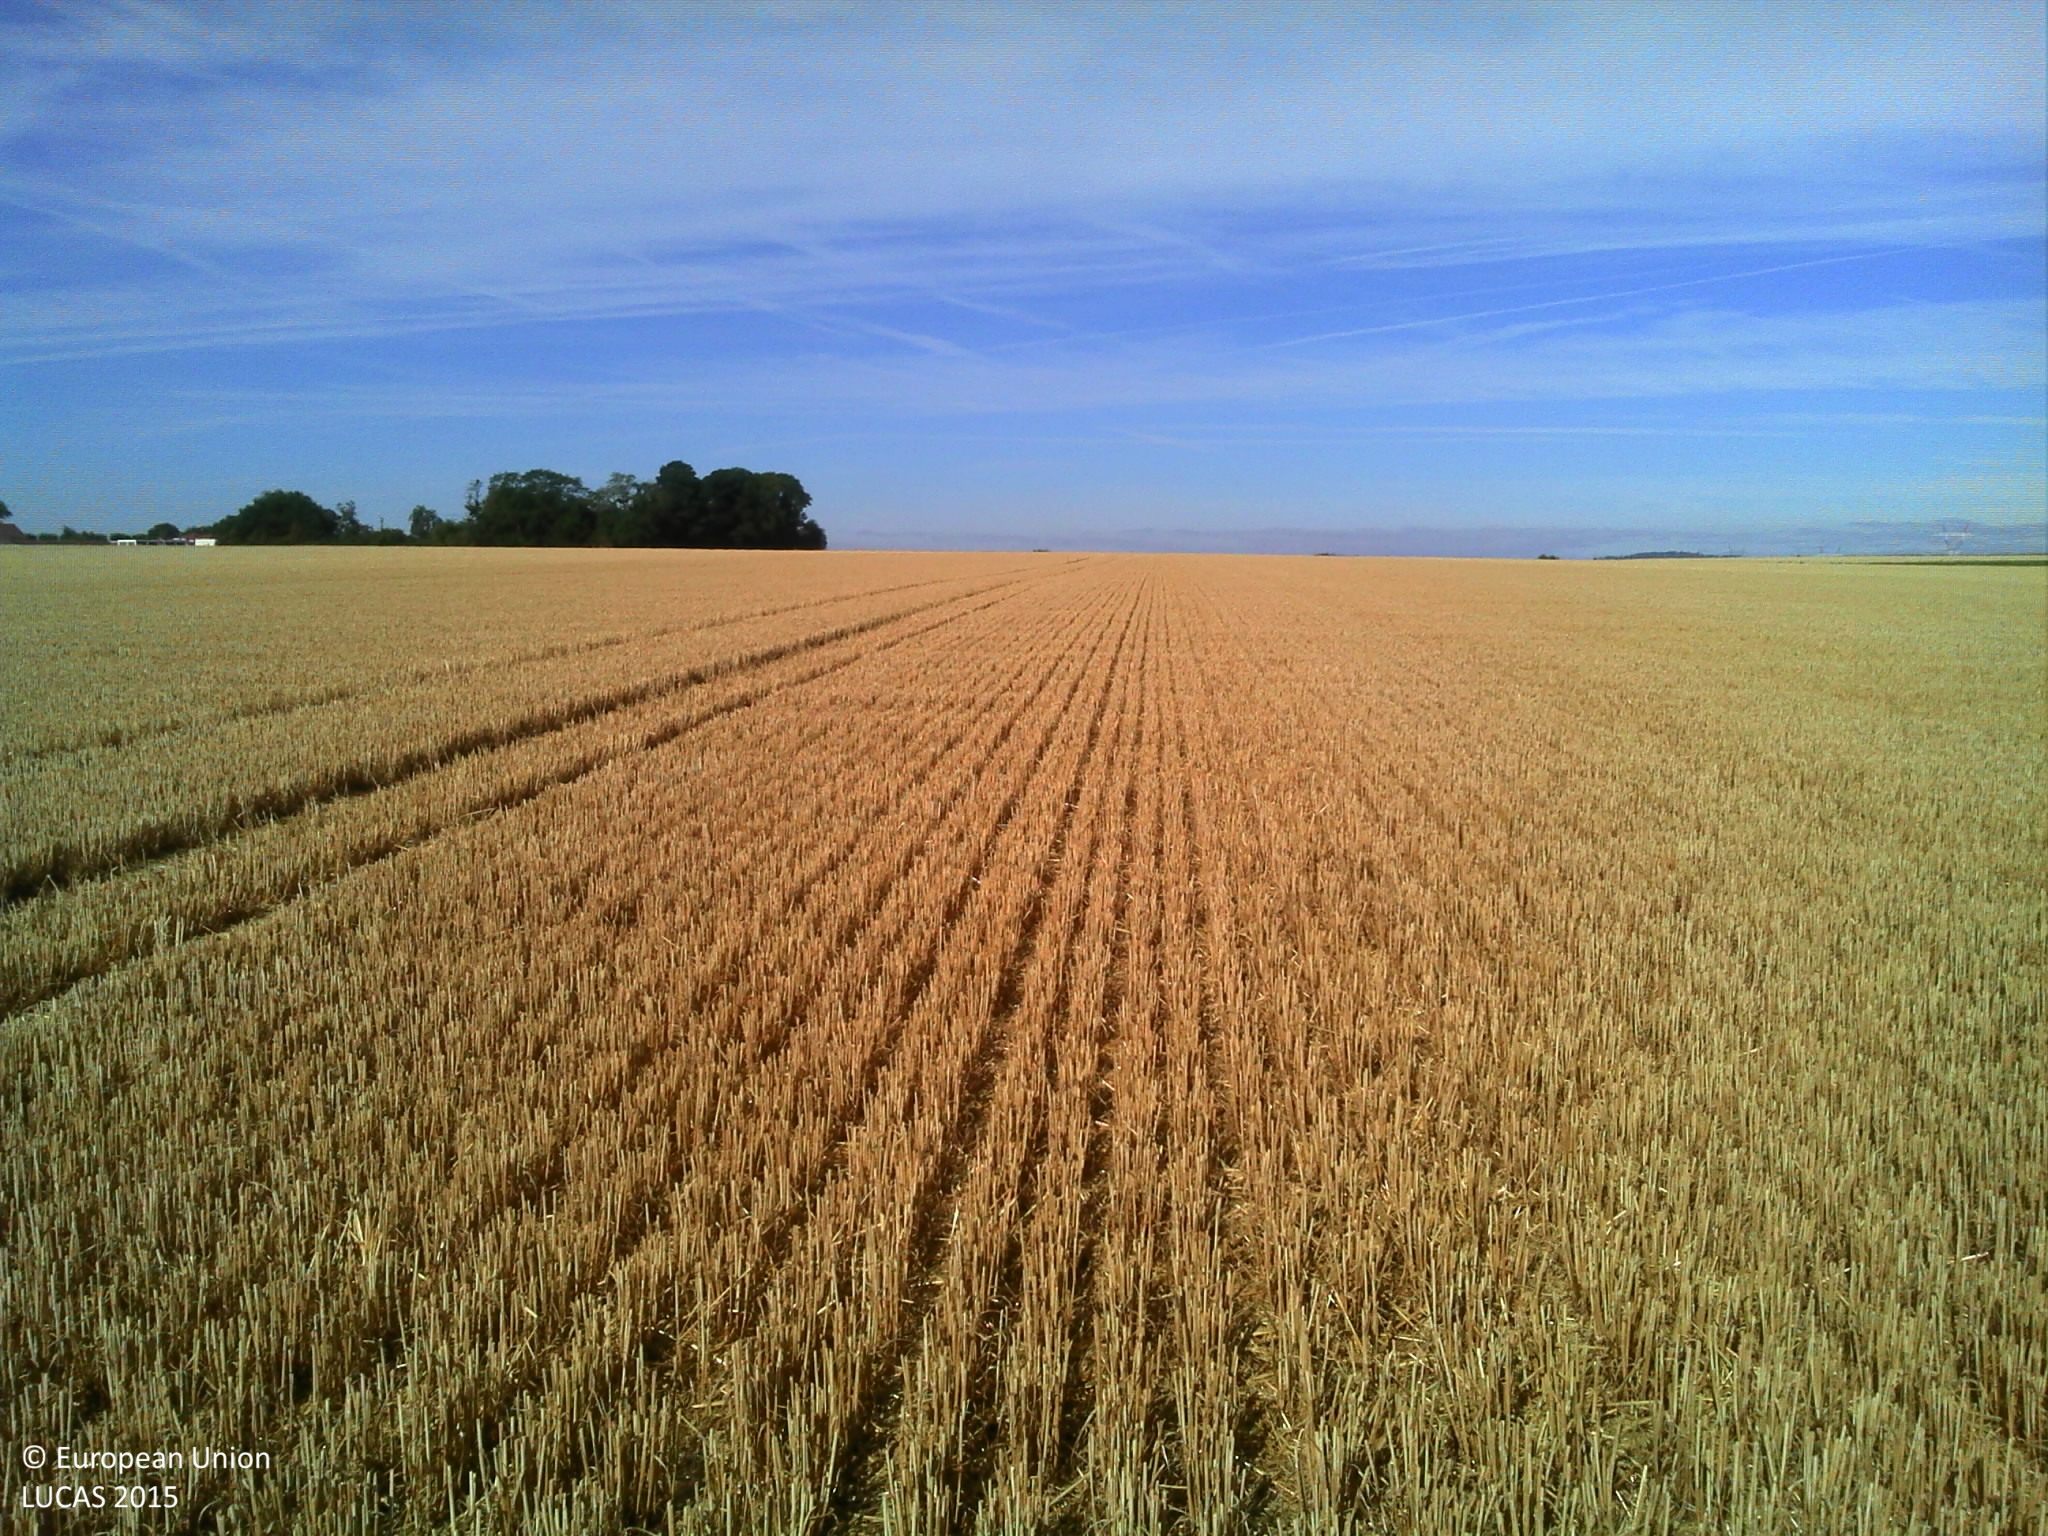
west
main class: Cropland
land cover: Common wheat
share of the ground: > 75 %
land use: Agriculture (excluding fallow land and kitchen gardens)
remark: Harvested field
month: August
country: FR
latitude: 49.0398
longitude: 2.5882
